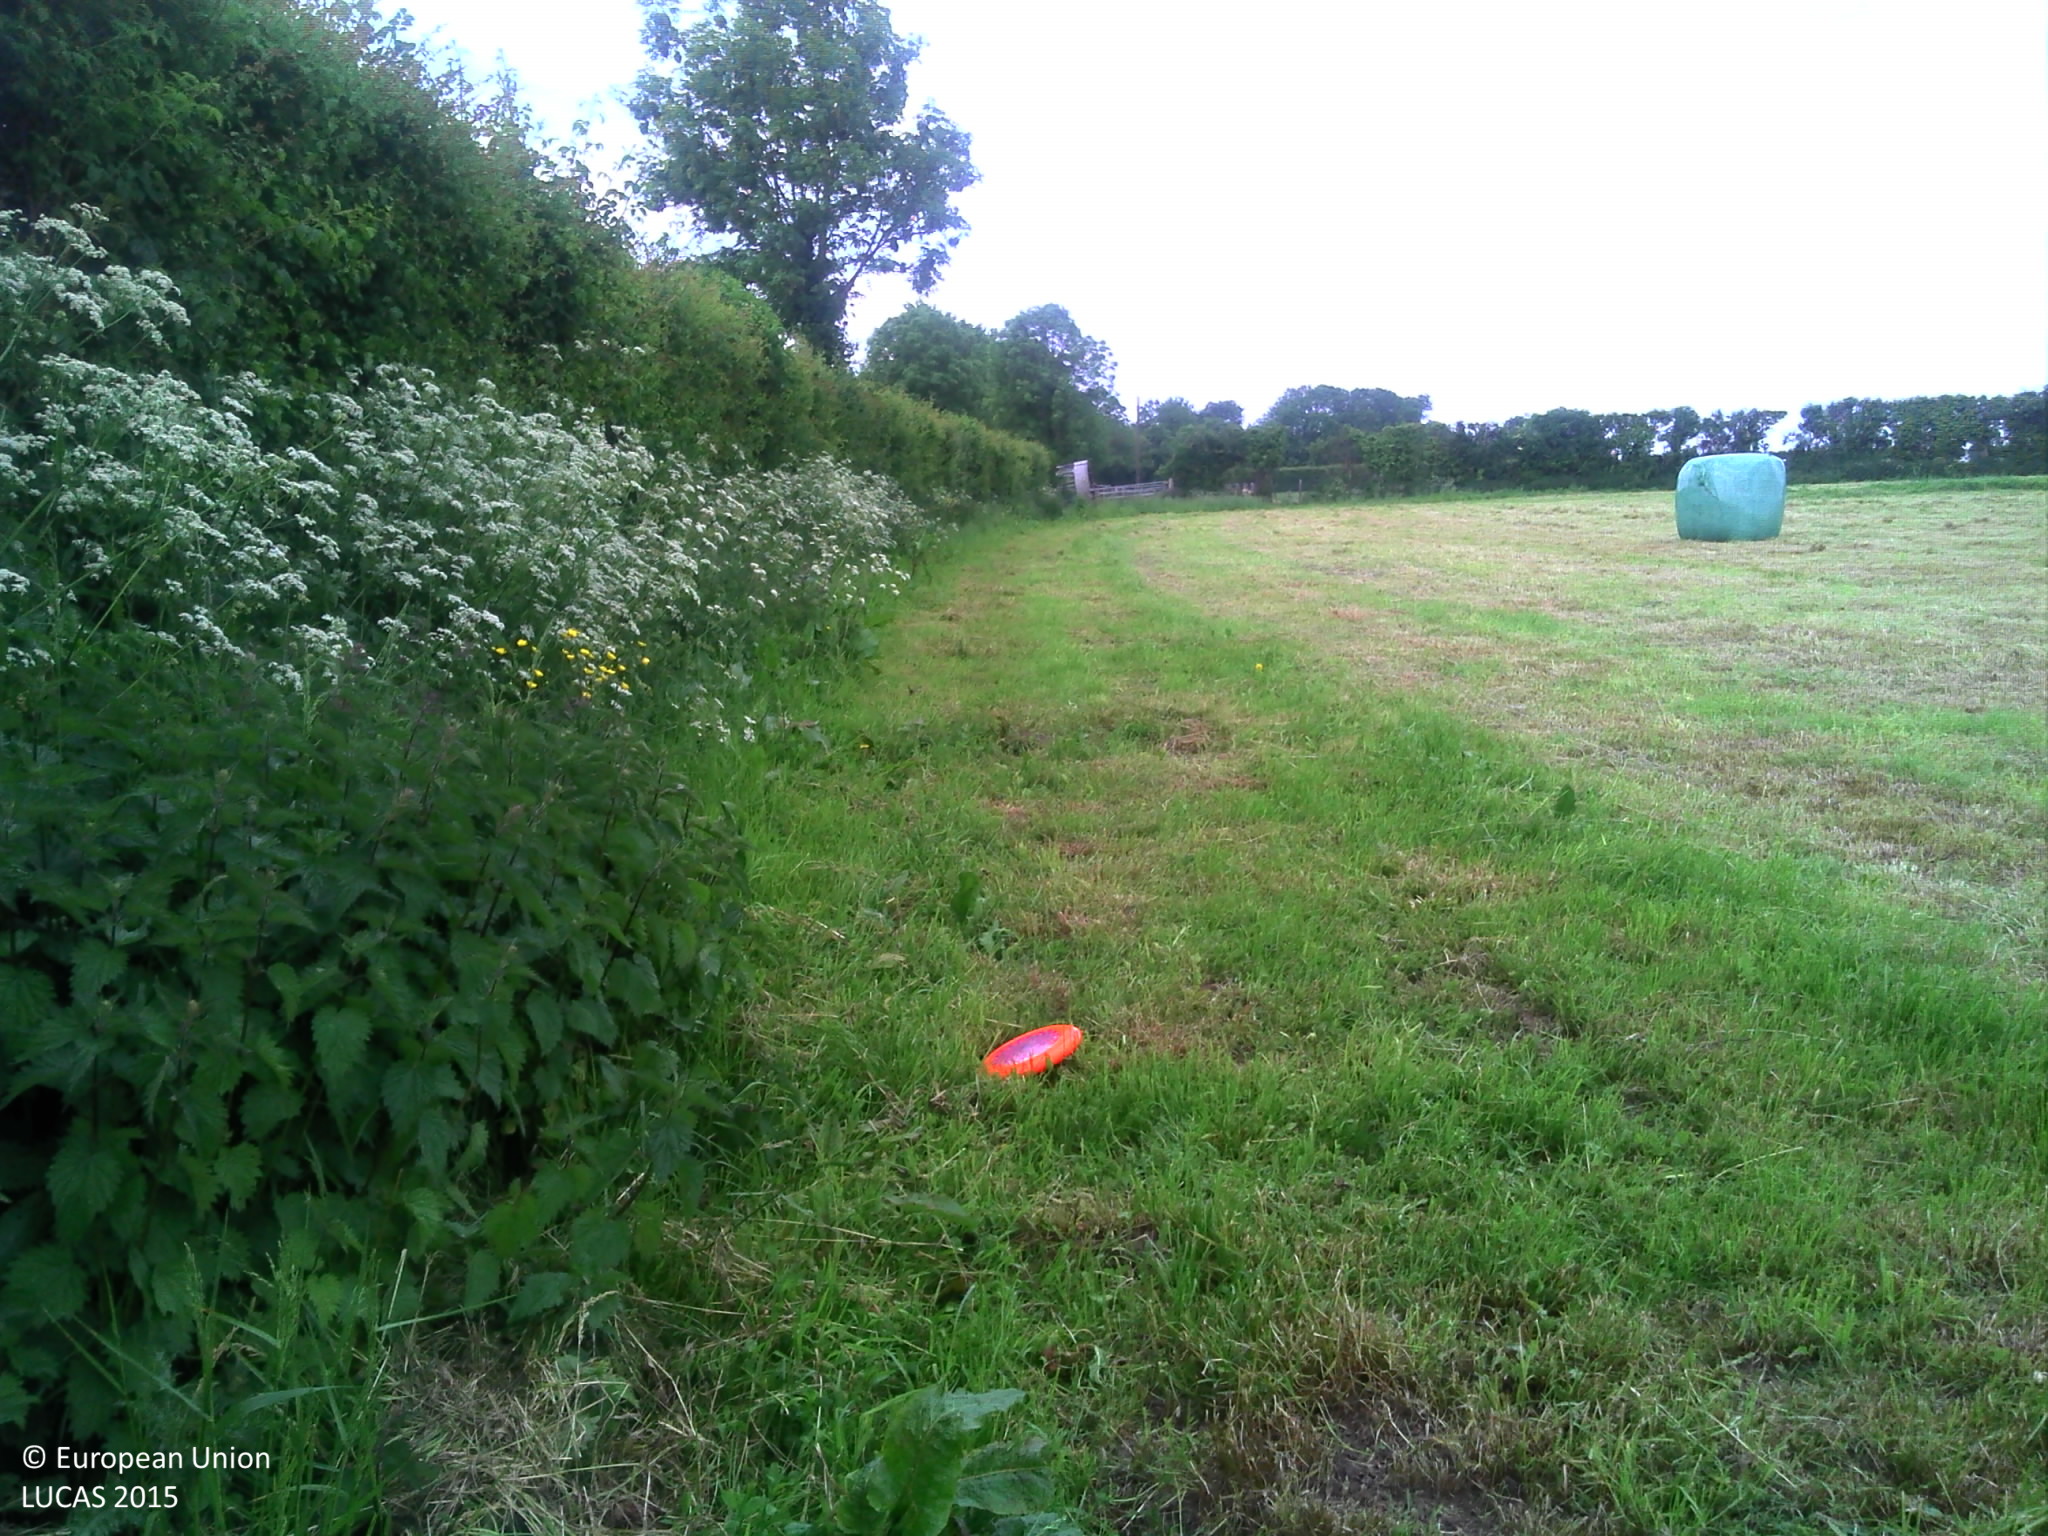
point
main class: Grassland
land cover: Grassland without tree/shrub cover
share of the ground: > 75 %
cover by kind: herbaceous plants 100 %
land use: Agriculture (excluding fallow land and kitchen gardens)
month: May
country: FR
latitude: 48.7879
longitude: -0.1448
